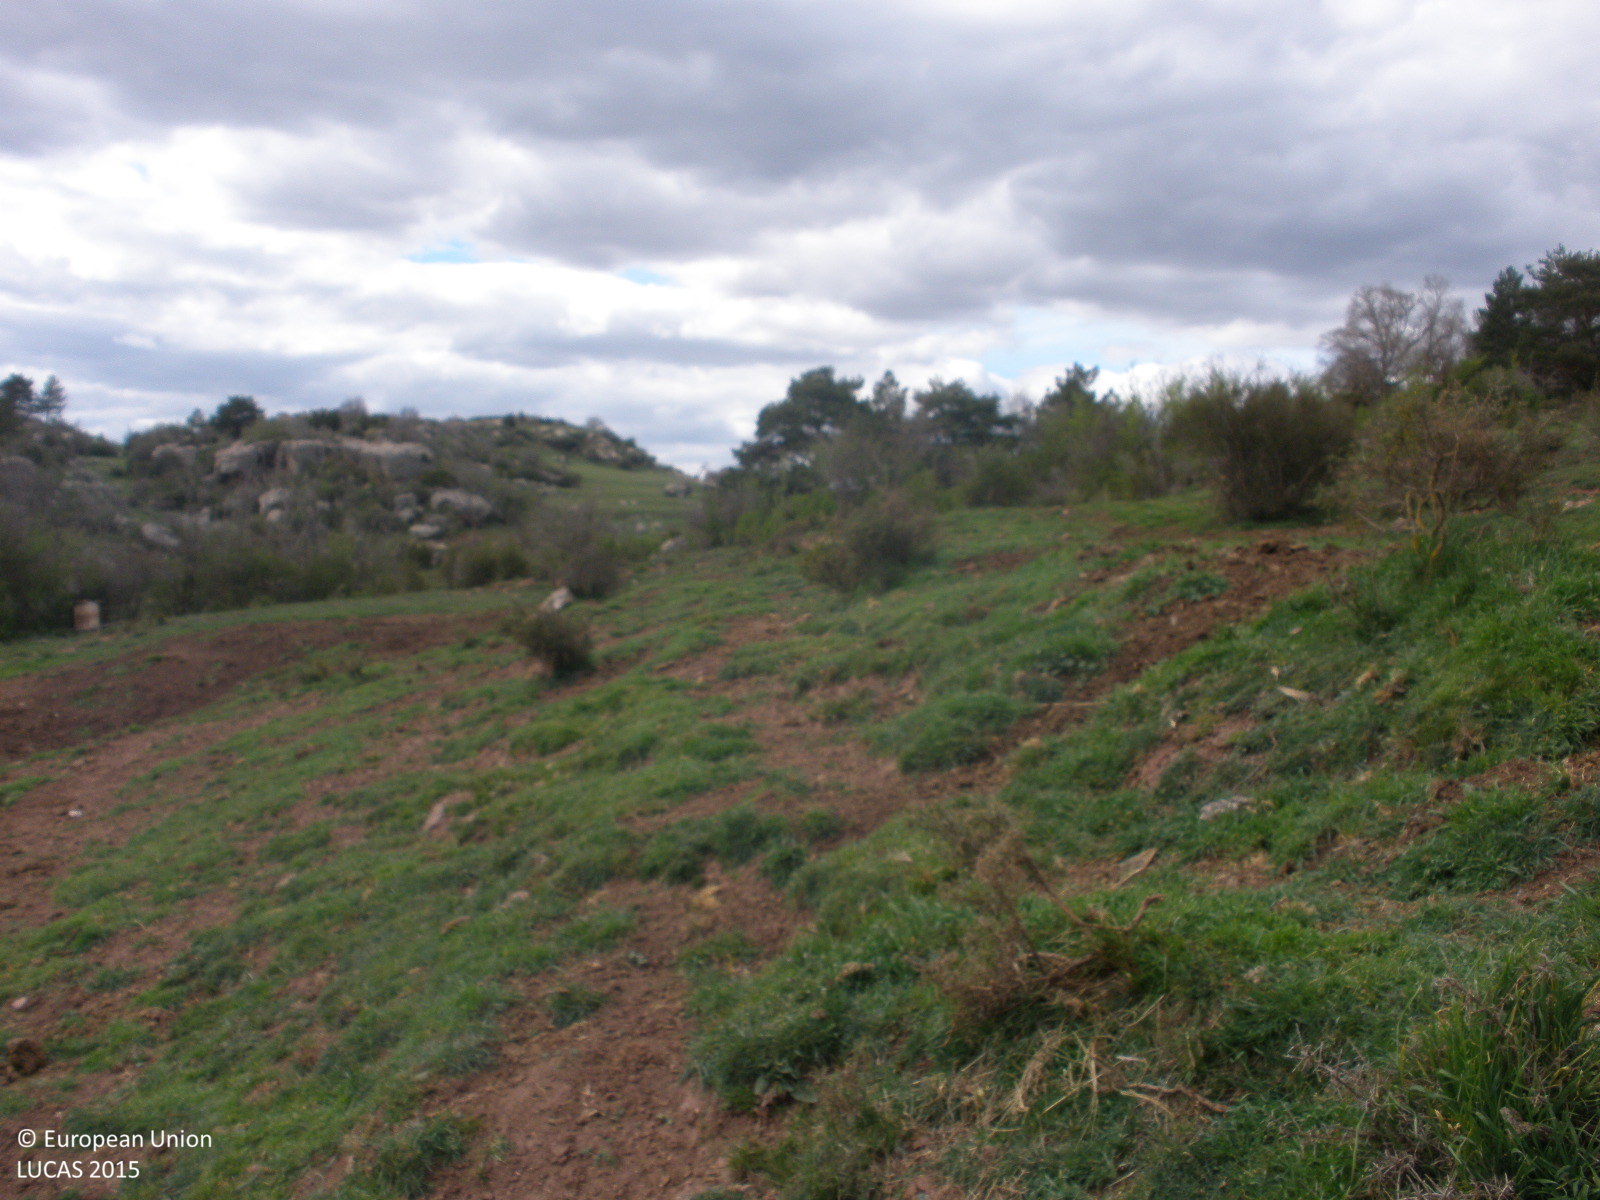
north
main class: Grassland
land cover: Grassland without tree/shrub cover
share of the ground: 50 - 75 %
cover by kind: herbaceous plants 50 %, unconsolidated bare surface 50 %
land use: Agriculture (excluding fallow land and kitchen gardens)
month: April
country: ES
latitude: 40.4152
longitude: -0.8162
